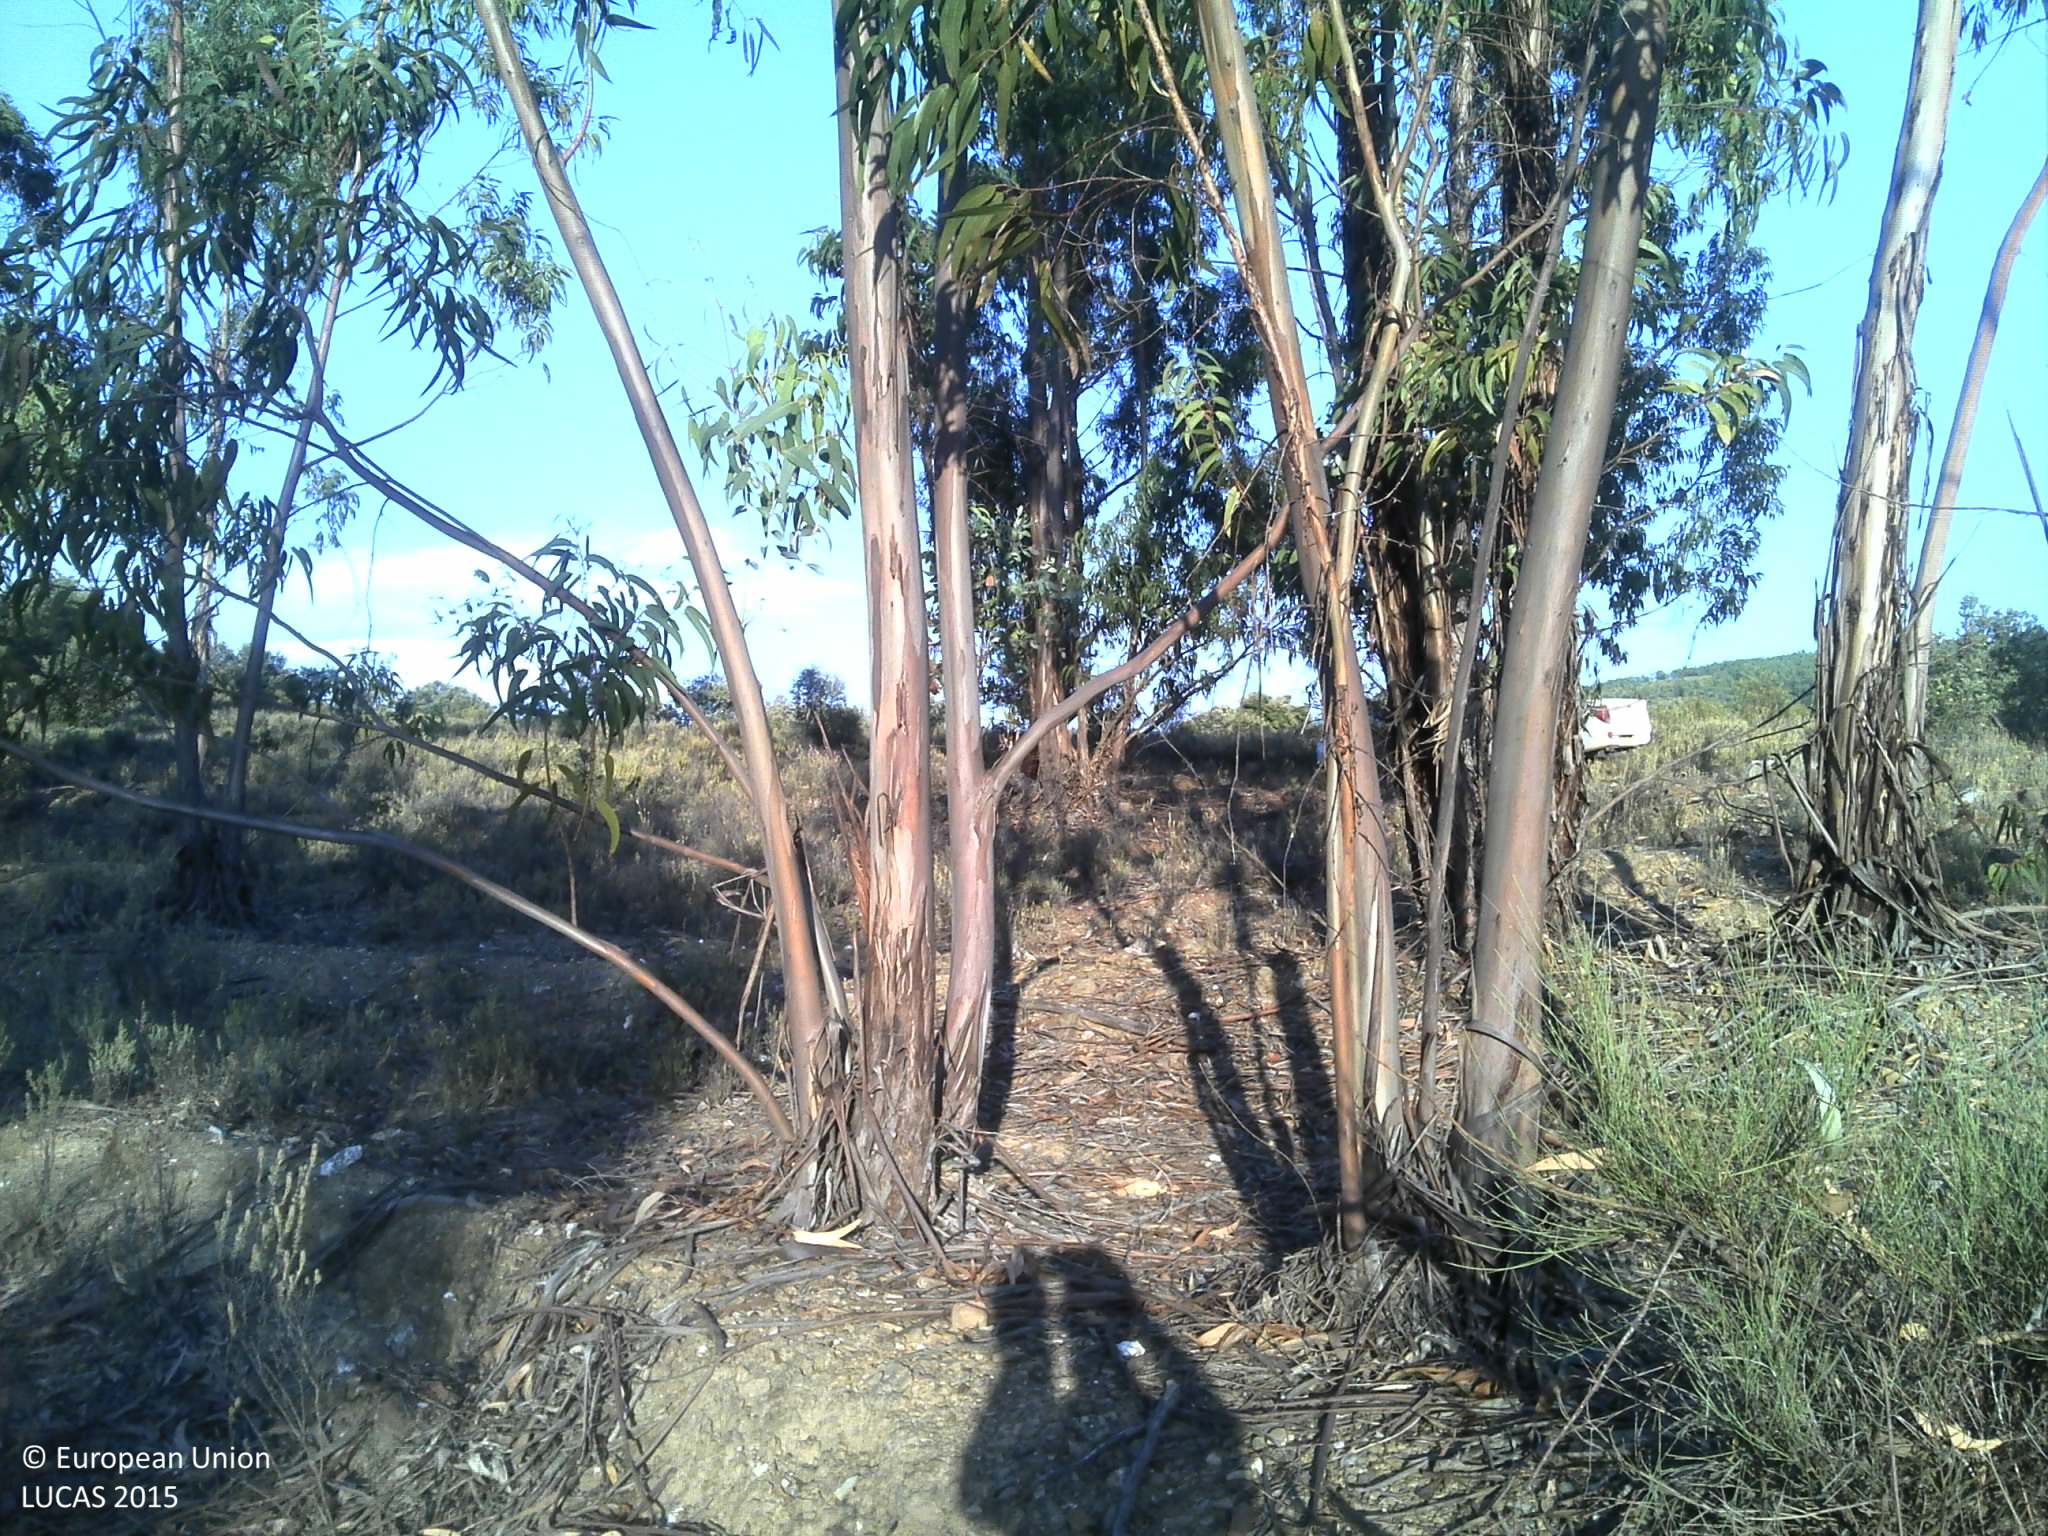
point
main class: Woodland
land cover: Broadleaved woodland
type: exotic forest
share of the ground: 25 - 50 %
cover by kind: unconsolidated bare surface 50 %, broadleaved forest trees 35 %, shrubs 5 %, herbaceous plants 5 %
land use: Forestry
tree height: > 5 m
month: June
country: PT
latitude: 39.9902
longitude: -6.9899
